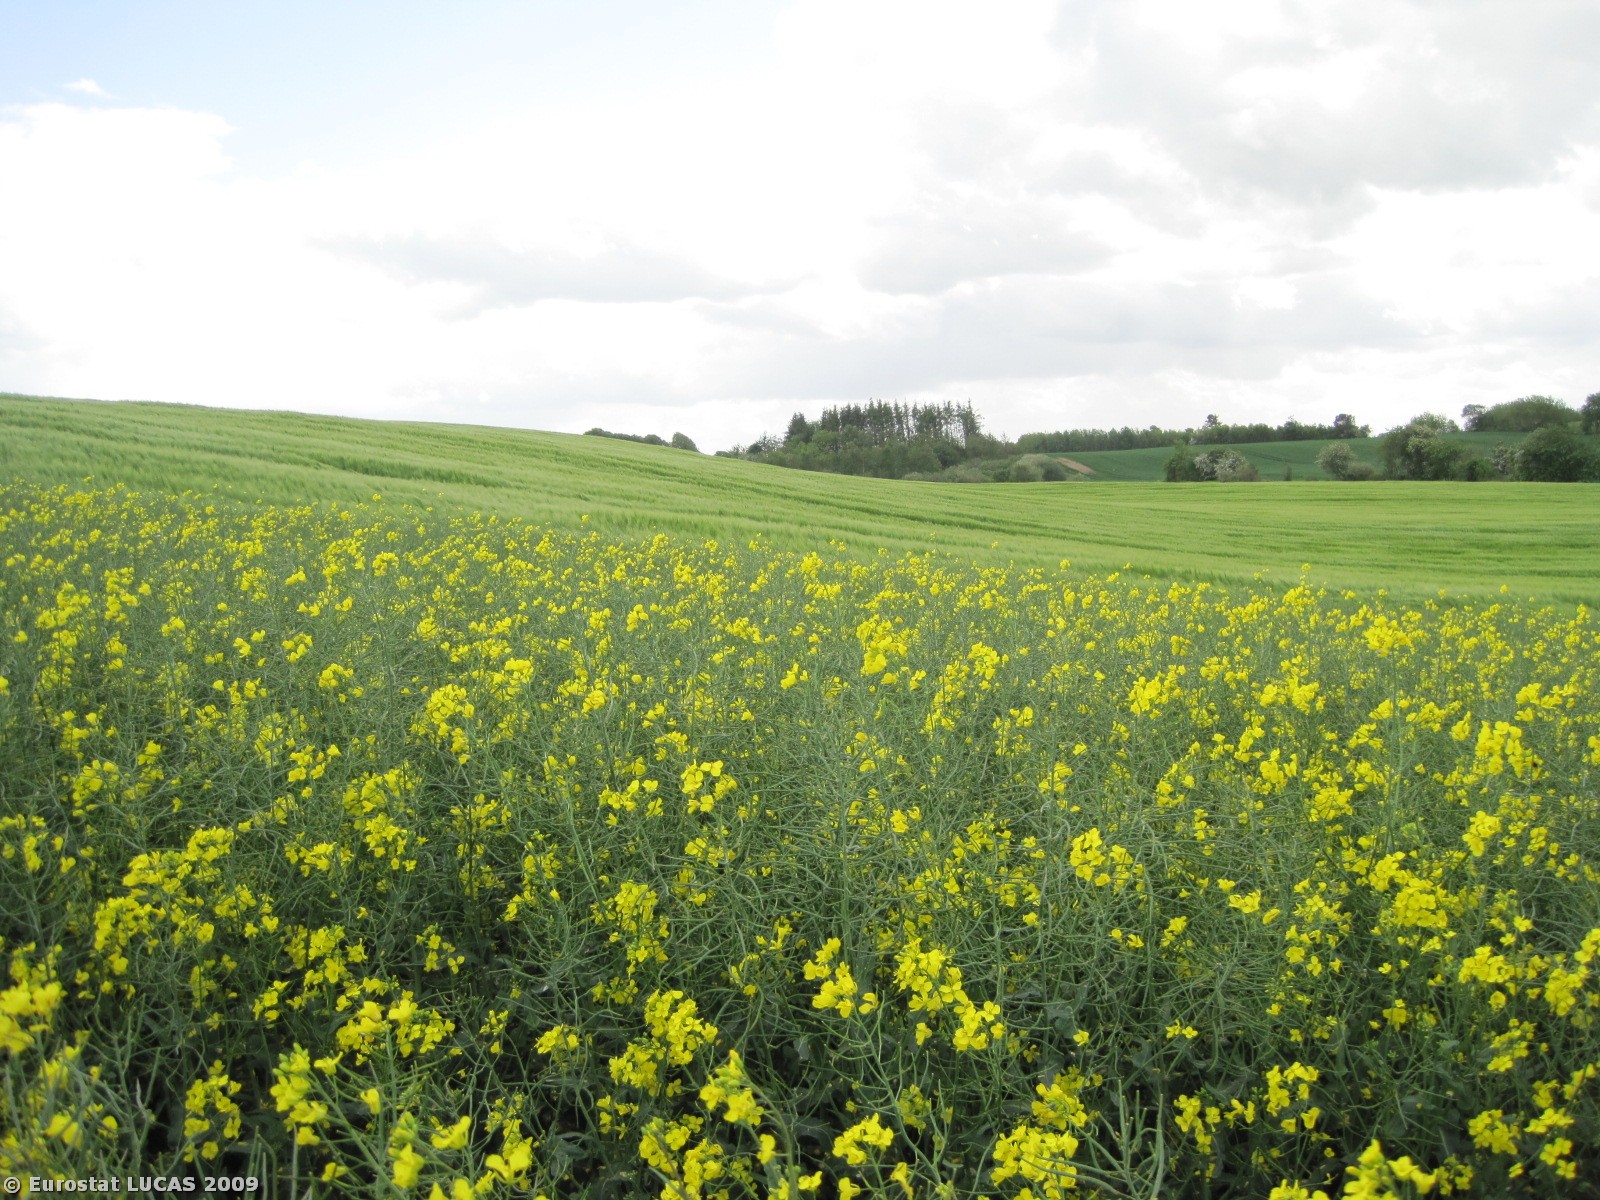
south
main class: Cropland
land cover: Rape and turnip rape
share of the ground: > 75 %
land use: Agriculture (excluding fallow land and kitchen gardens)
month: May
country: DK
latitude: 56.5652
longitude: 9.8862
